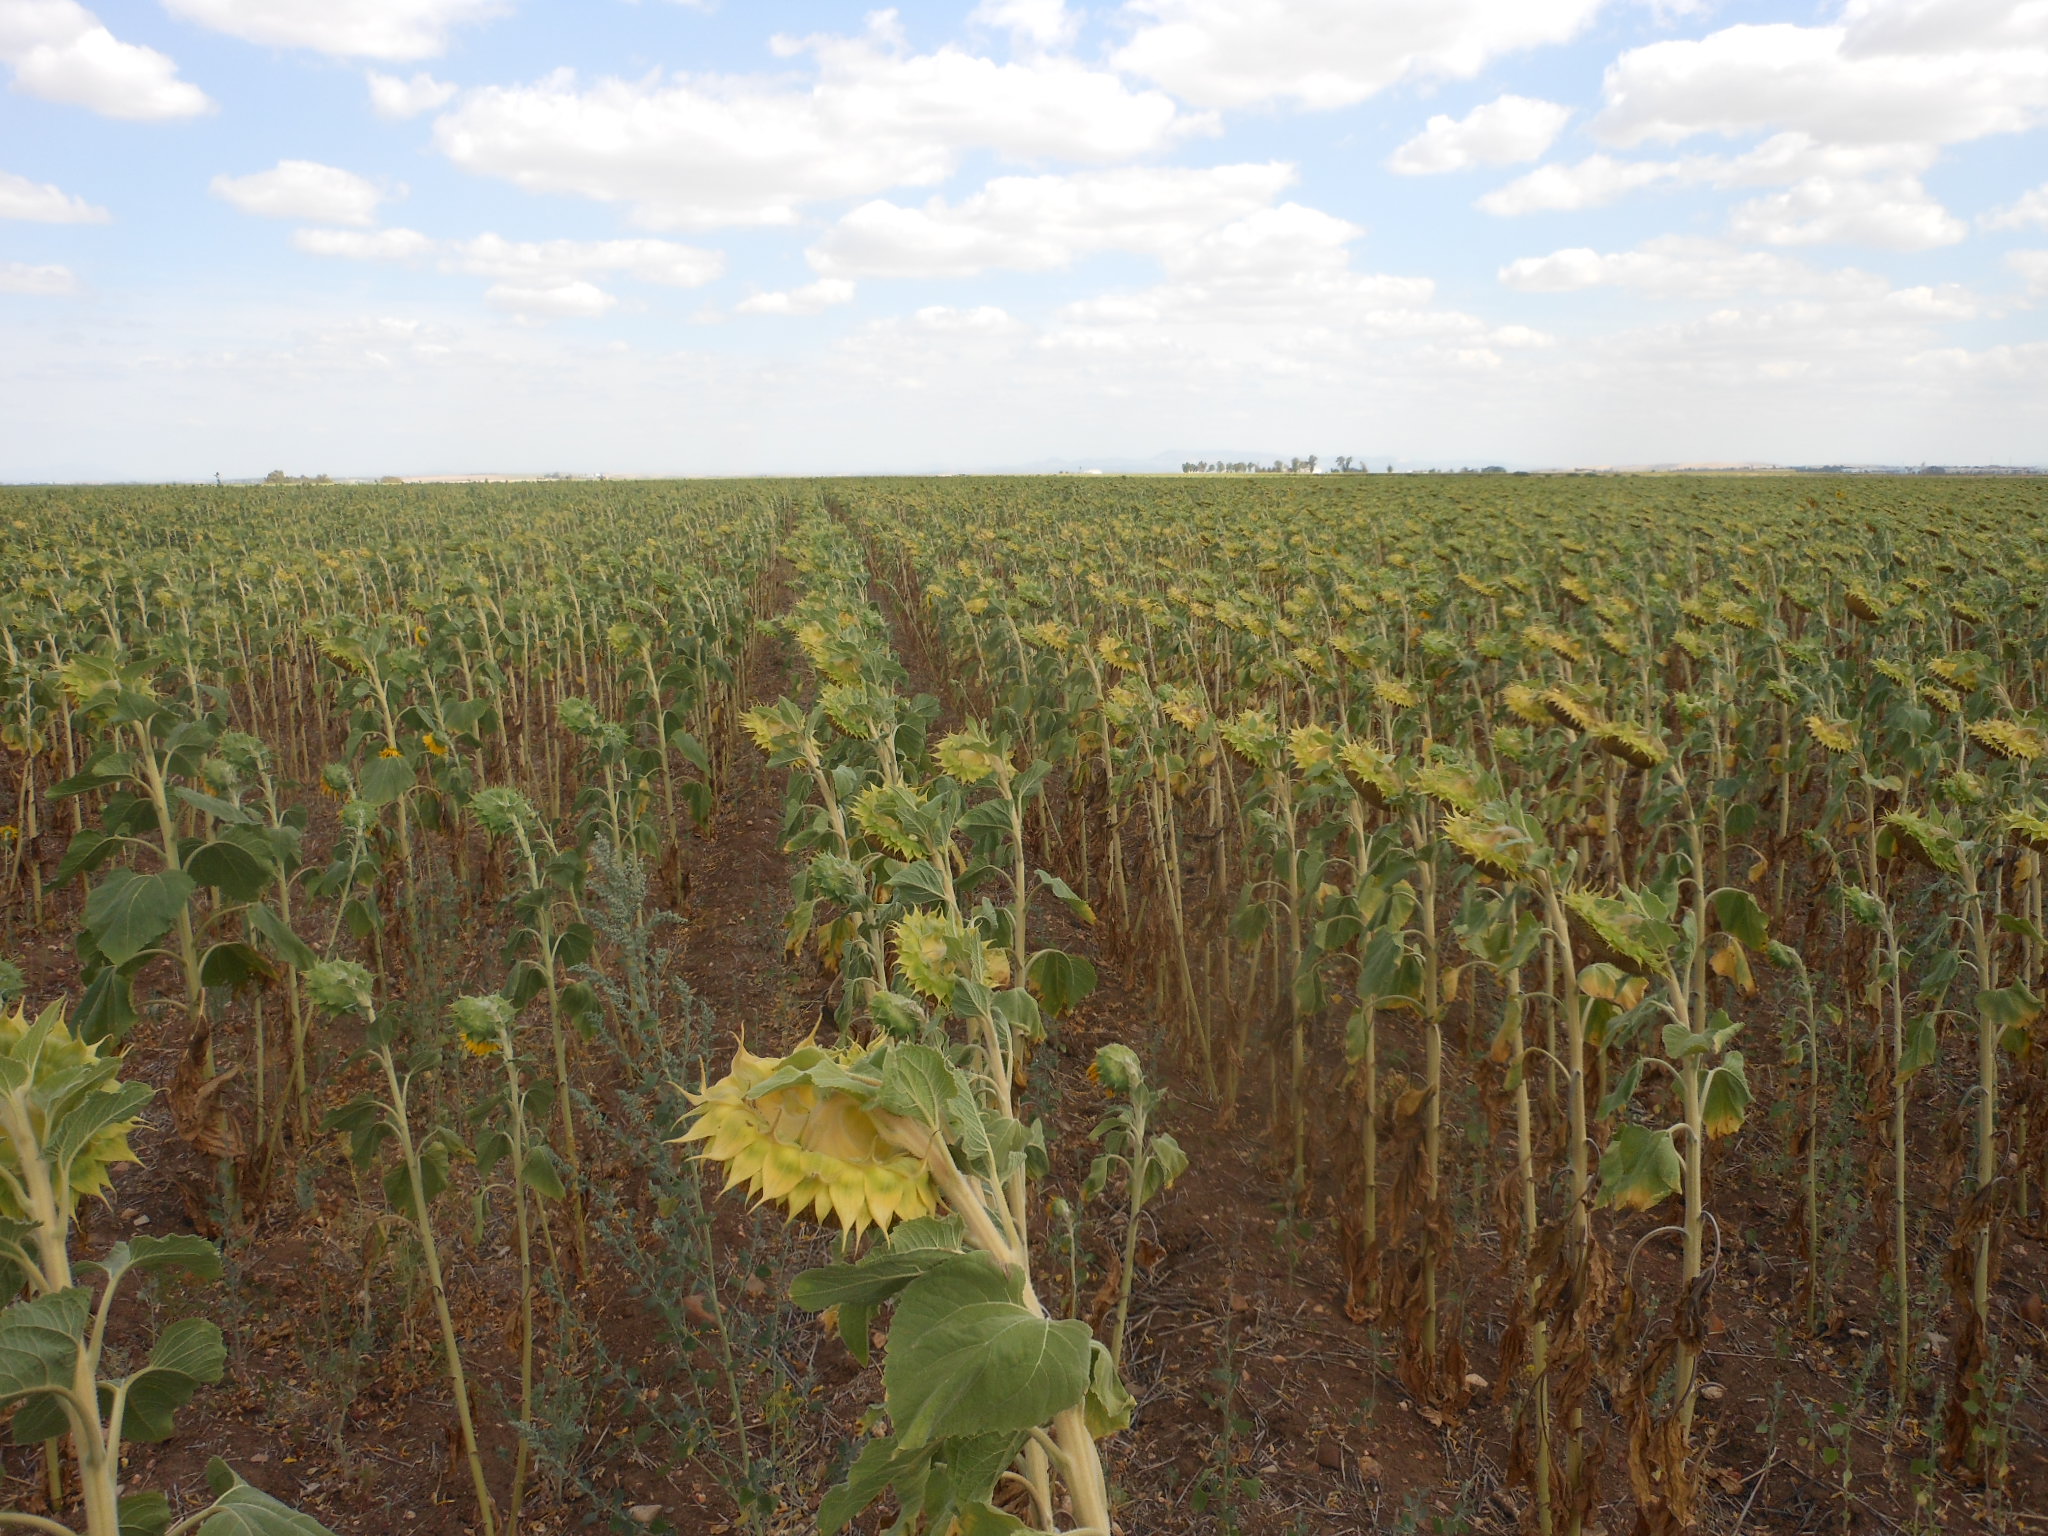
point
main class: Cropland
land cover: Sunflower
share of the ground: > 75 %
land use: Agriculture (excluding fallow land and kitchen gardens)
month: June
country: ES
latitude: 37.5785
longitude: -5.1307
